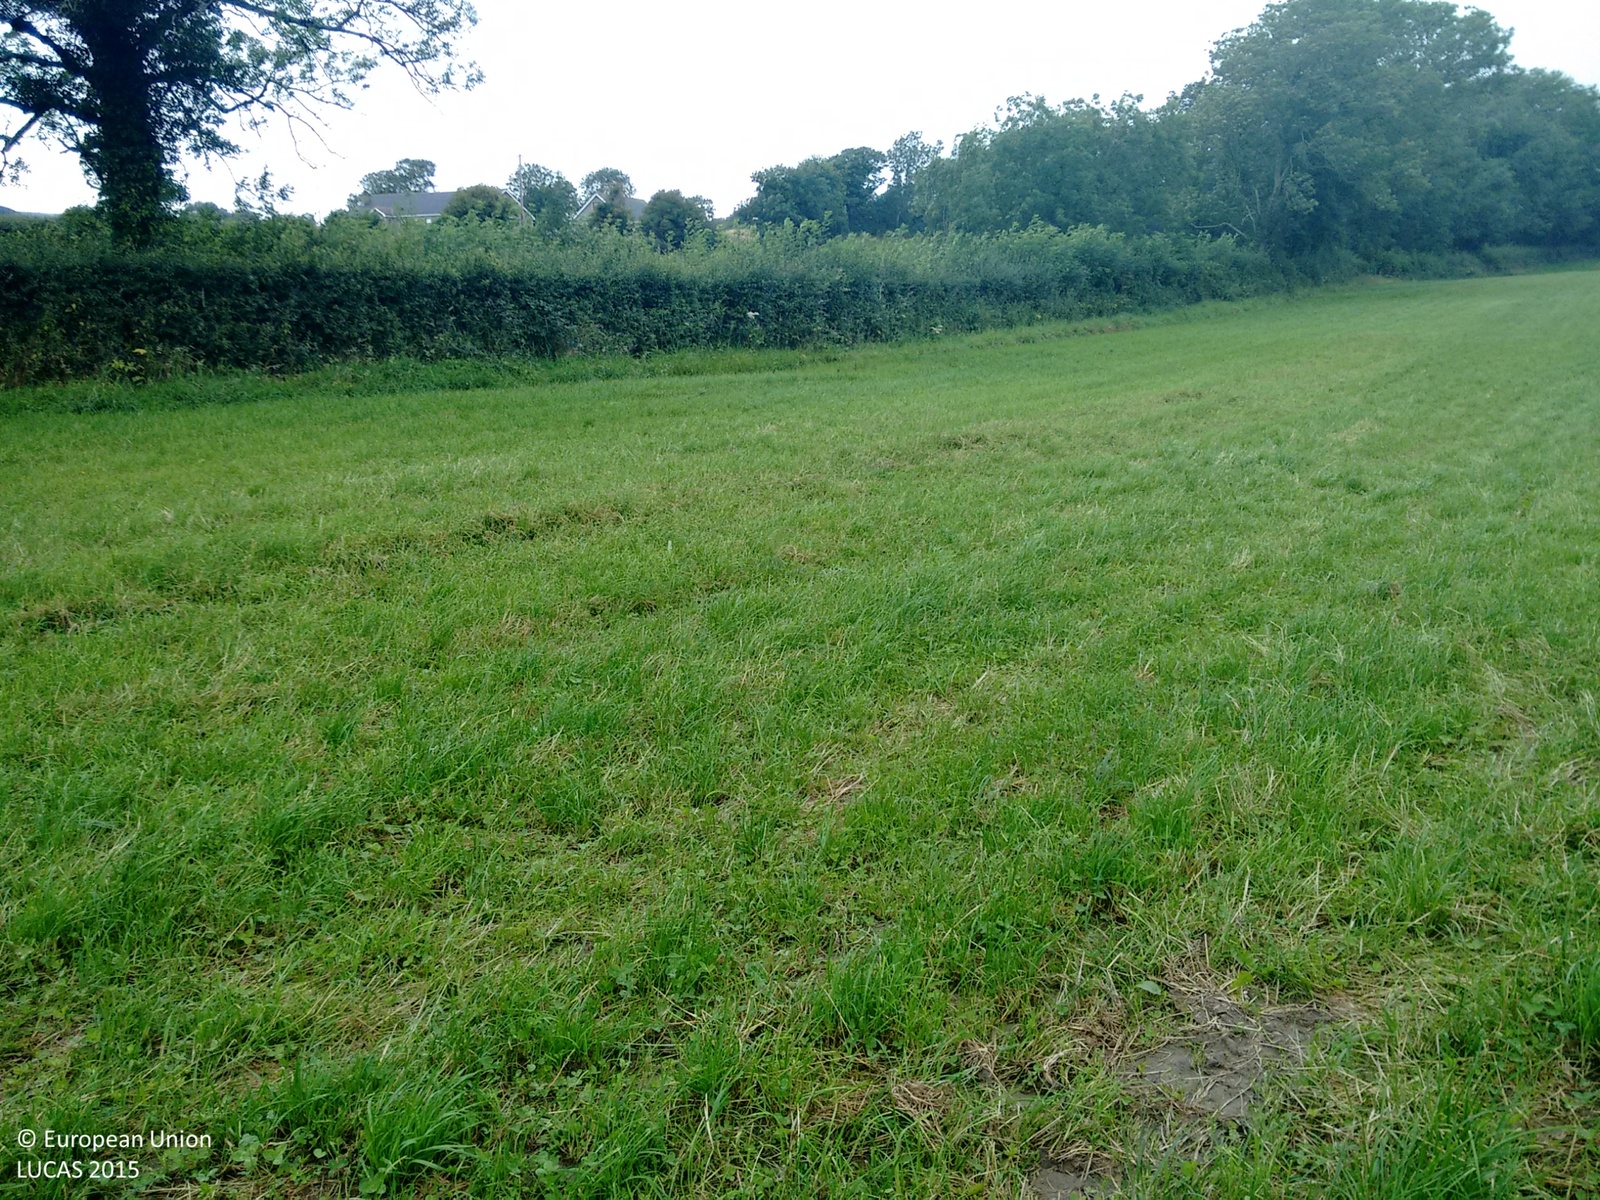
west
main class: Grassland
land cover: Grassland without tree/shrub cover
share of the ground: > 75 %
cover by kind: herbaceous plants 100 %
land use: Agriculture (excluding fallow land and kitchen gardens)
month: August
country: GB
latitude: 54.3571
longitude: -5.7845
